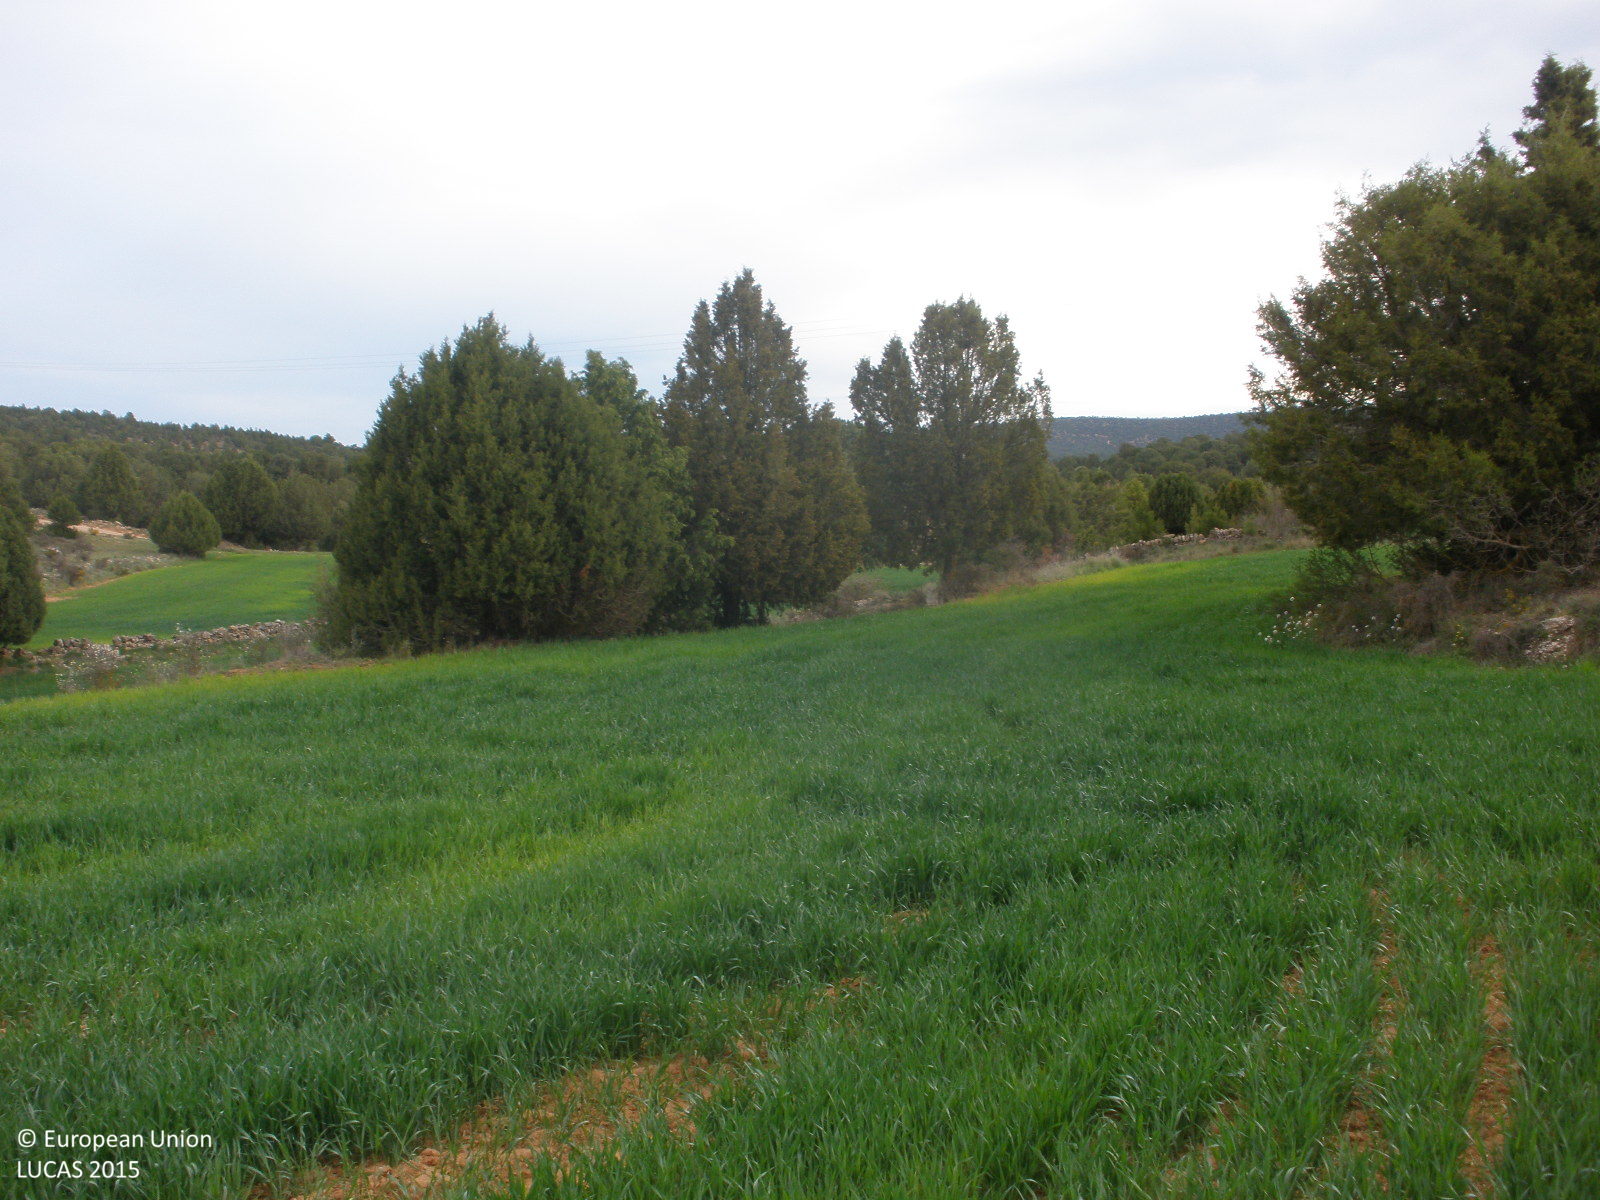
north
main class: Cropland
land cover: Barley
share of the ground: > 75 %
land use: Agriculture (excluding fallow land and kitchen gardens)
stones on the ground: < 10 %
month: May
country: ES
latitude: 40.4124
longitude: -1.0055
